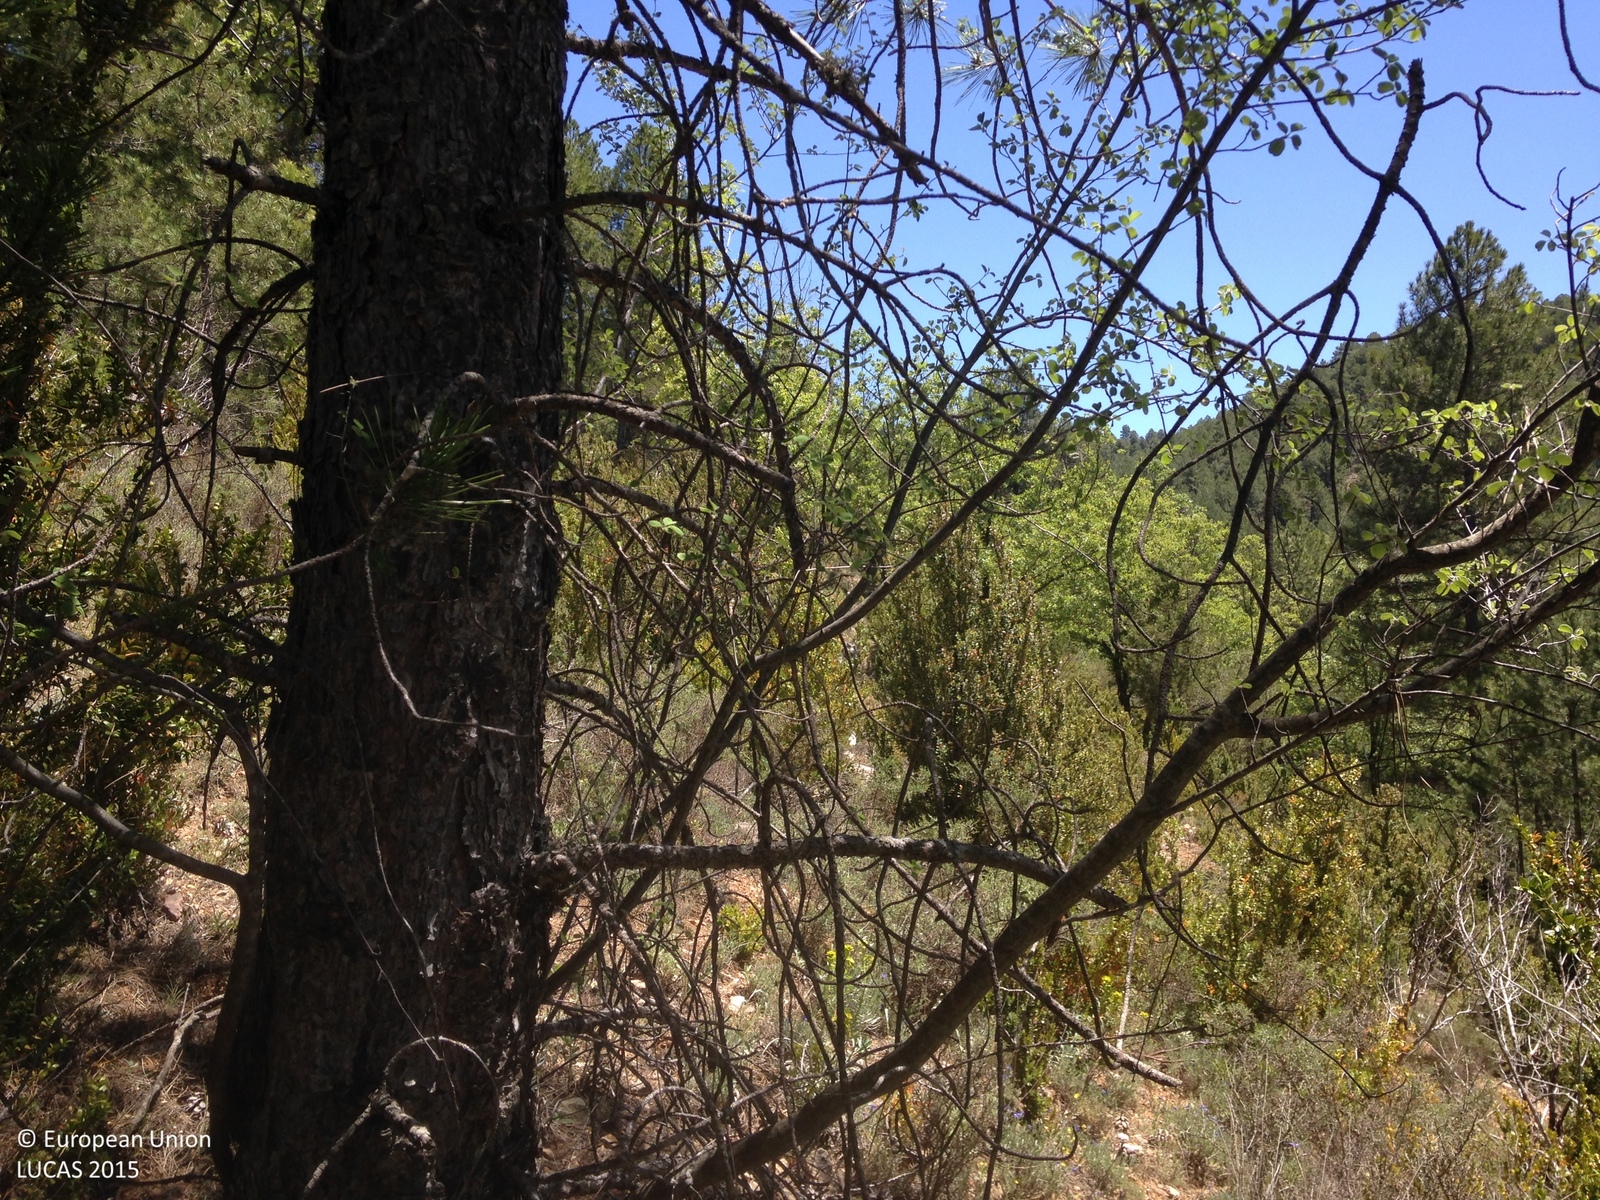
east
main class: Woodland
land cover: Pine dominated coniferous woodland
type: coniferous forest of the mediterranean region
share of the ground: 50 - 75 %
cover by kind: coniferous forest trees 60 %, shrubs 20 %, herbaceous plants 20 %
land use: Semi-natural and natural areas not in use
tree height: > 5 m
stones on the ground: > 50 %
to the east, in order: Pine dominated coniferous woodland; Shrubland with sparse tree cover; Paved roads, cycling and walking lanes; Pine dominated coniferous woodland; Electric lines; Broadleaved woodland; Inland fresh running water; Broadleaved woodland; Shrubland without tree cover
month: May
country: ES
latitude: 40.5116
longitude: -2.0222
